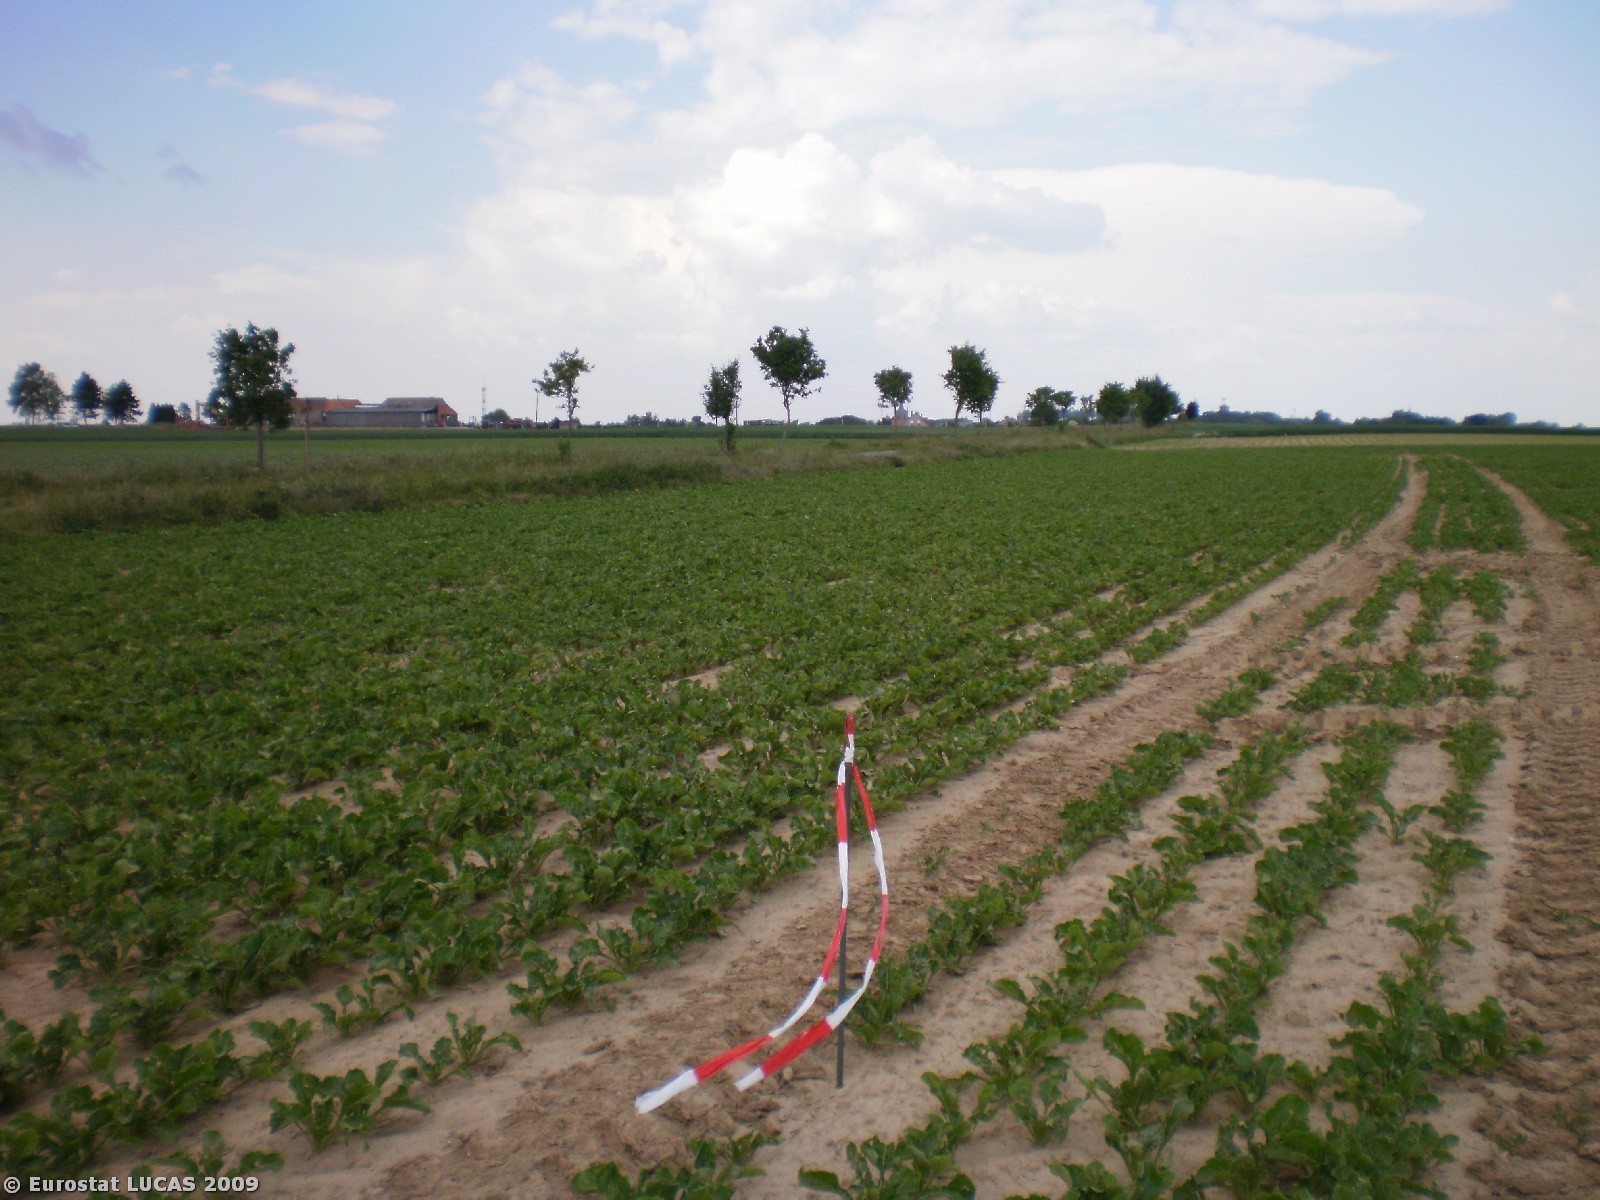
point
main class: Cropland
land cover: Sugar beet
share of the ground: 50 - 75 %
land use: Agriculture (excluding fallow land and kitchen gardens)
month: June
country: BE
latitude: 50.5743
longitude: 3.7945
